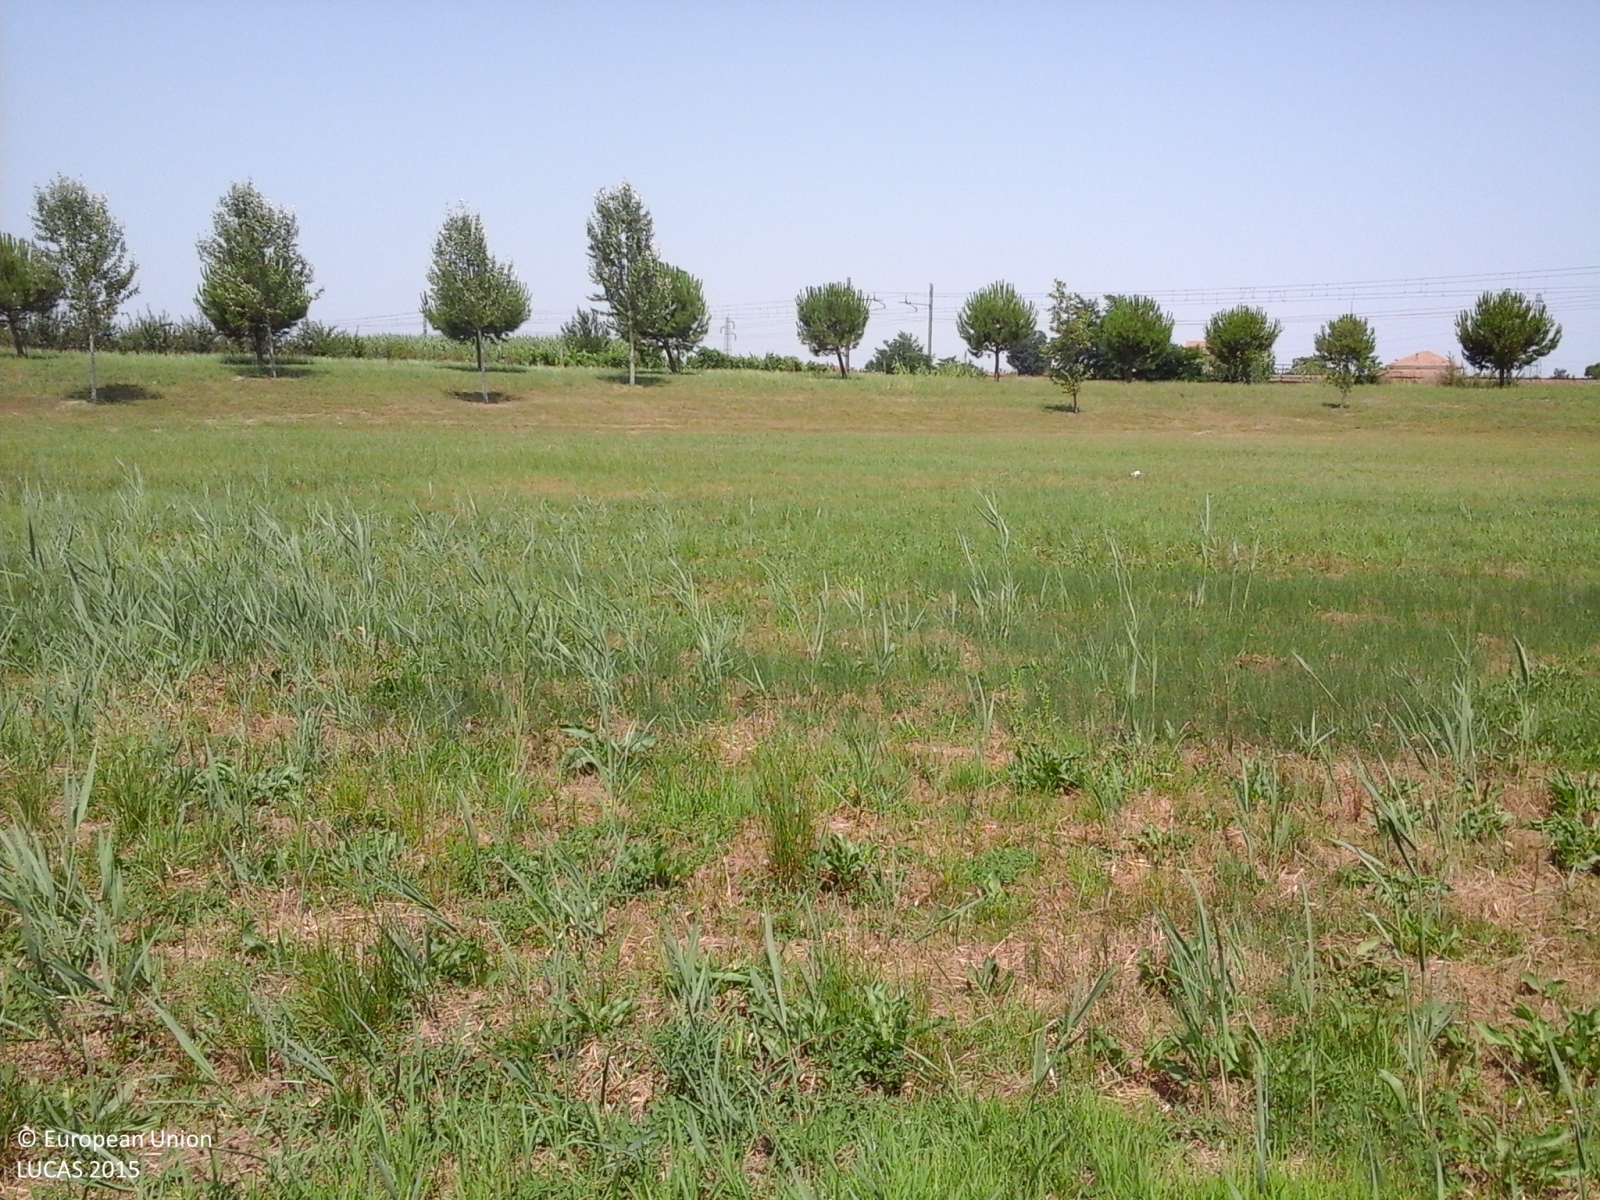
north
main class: Grassland
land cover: Spontaneously vegetated surfaces
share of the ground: > 75 %
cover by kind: herbaceous plants 100 %
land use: Fallow land
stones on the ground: < 10 %
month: July
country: IT
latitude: 44.1073
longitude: 12.3559
